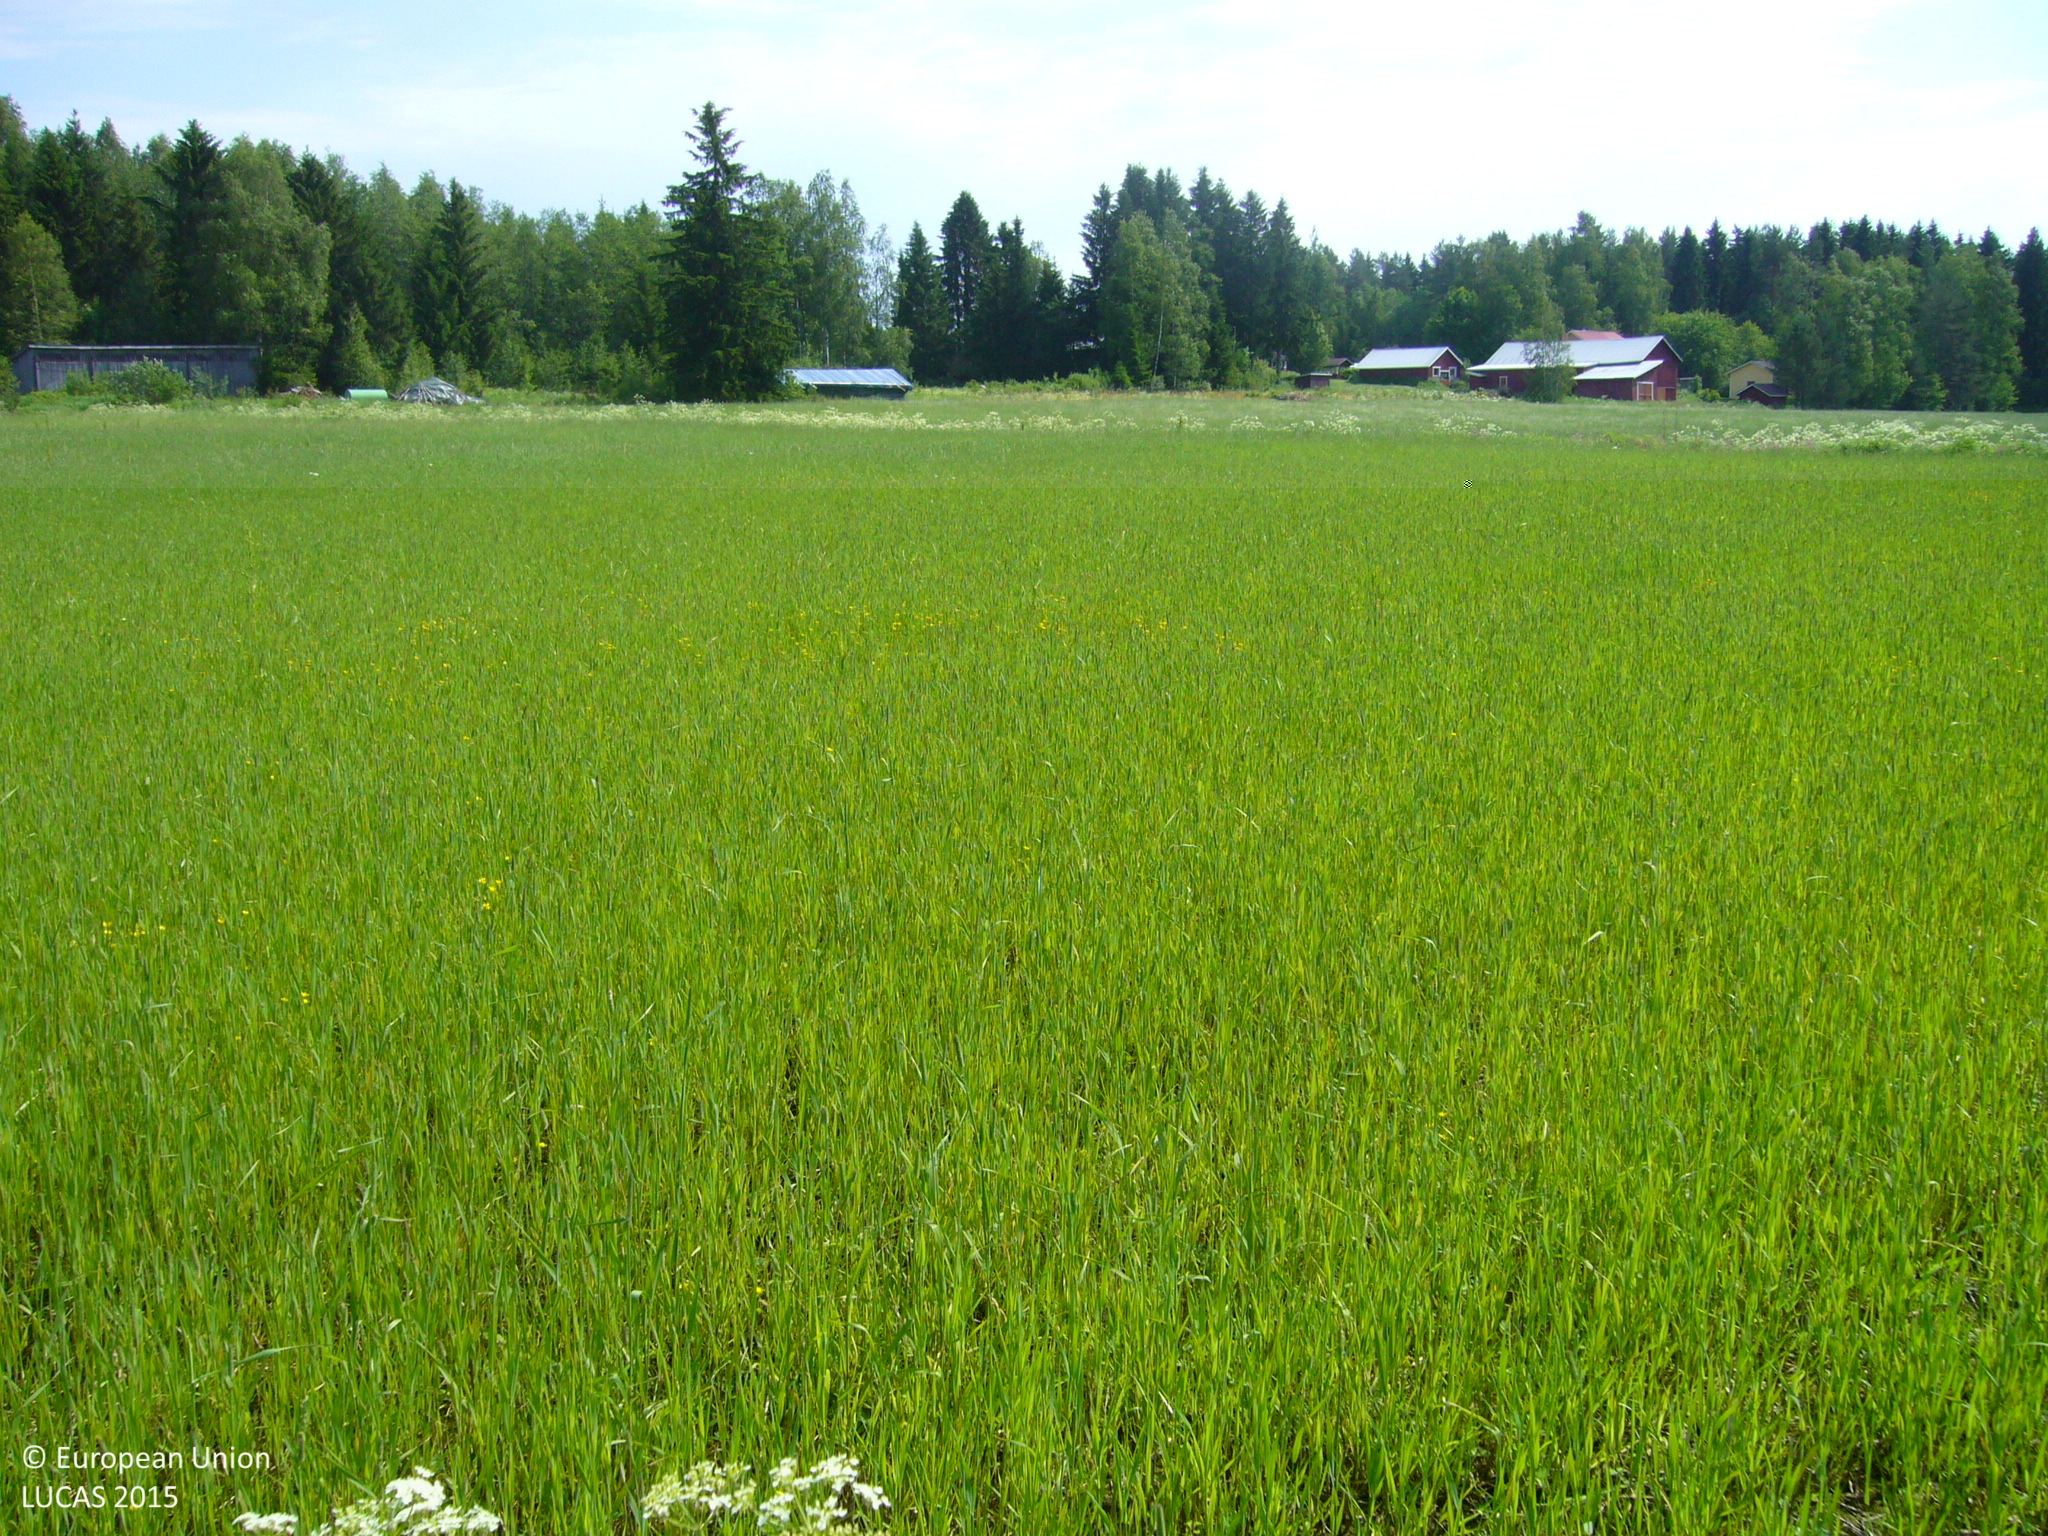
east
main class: Cropland
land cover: Temporary grasslands
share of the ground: > 75 %
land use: Agriculture (excluding fallow land and kitchen gardens)
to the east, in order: Temporary grasslands; Ditches and canals; Temporary grasslands; Ditches and canals; Temporary grasslands
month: July
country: FI
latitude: 63.6330
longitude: 25.8294
